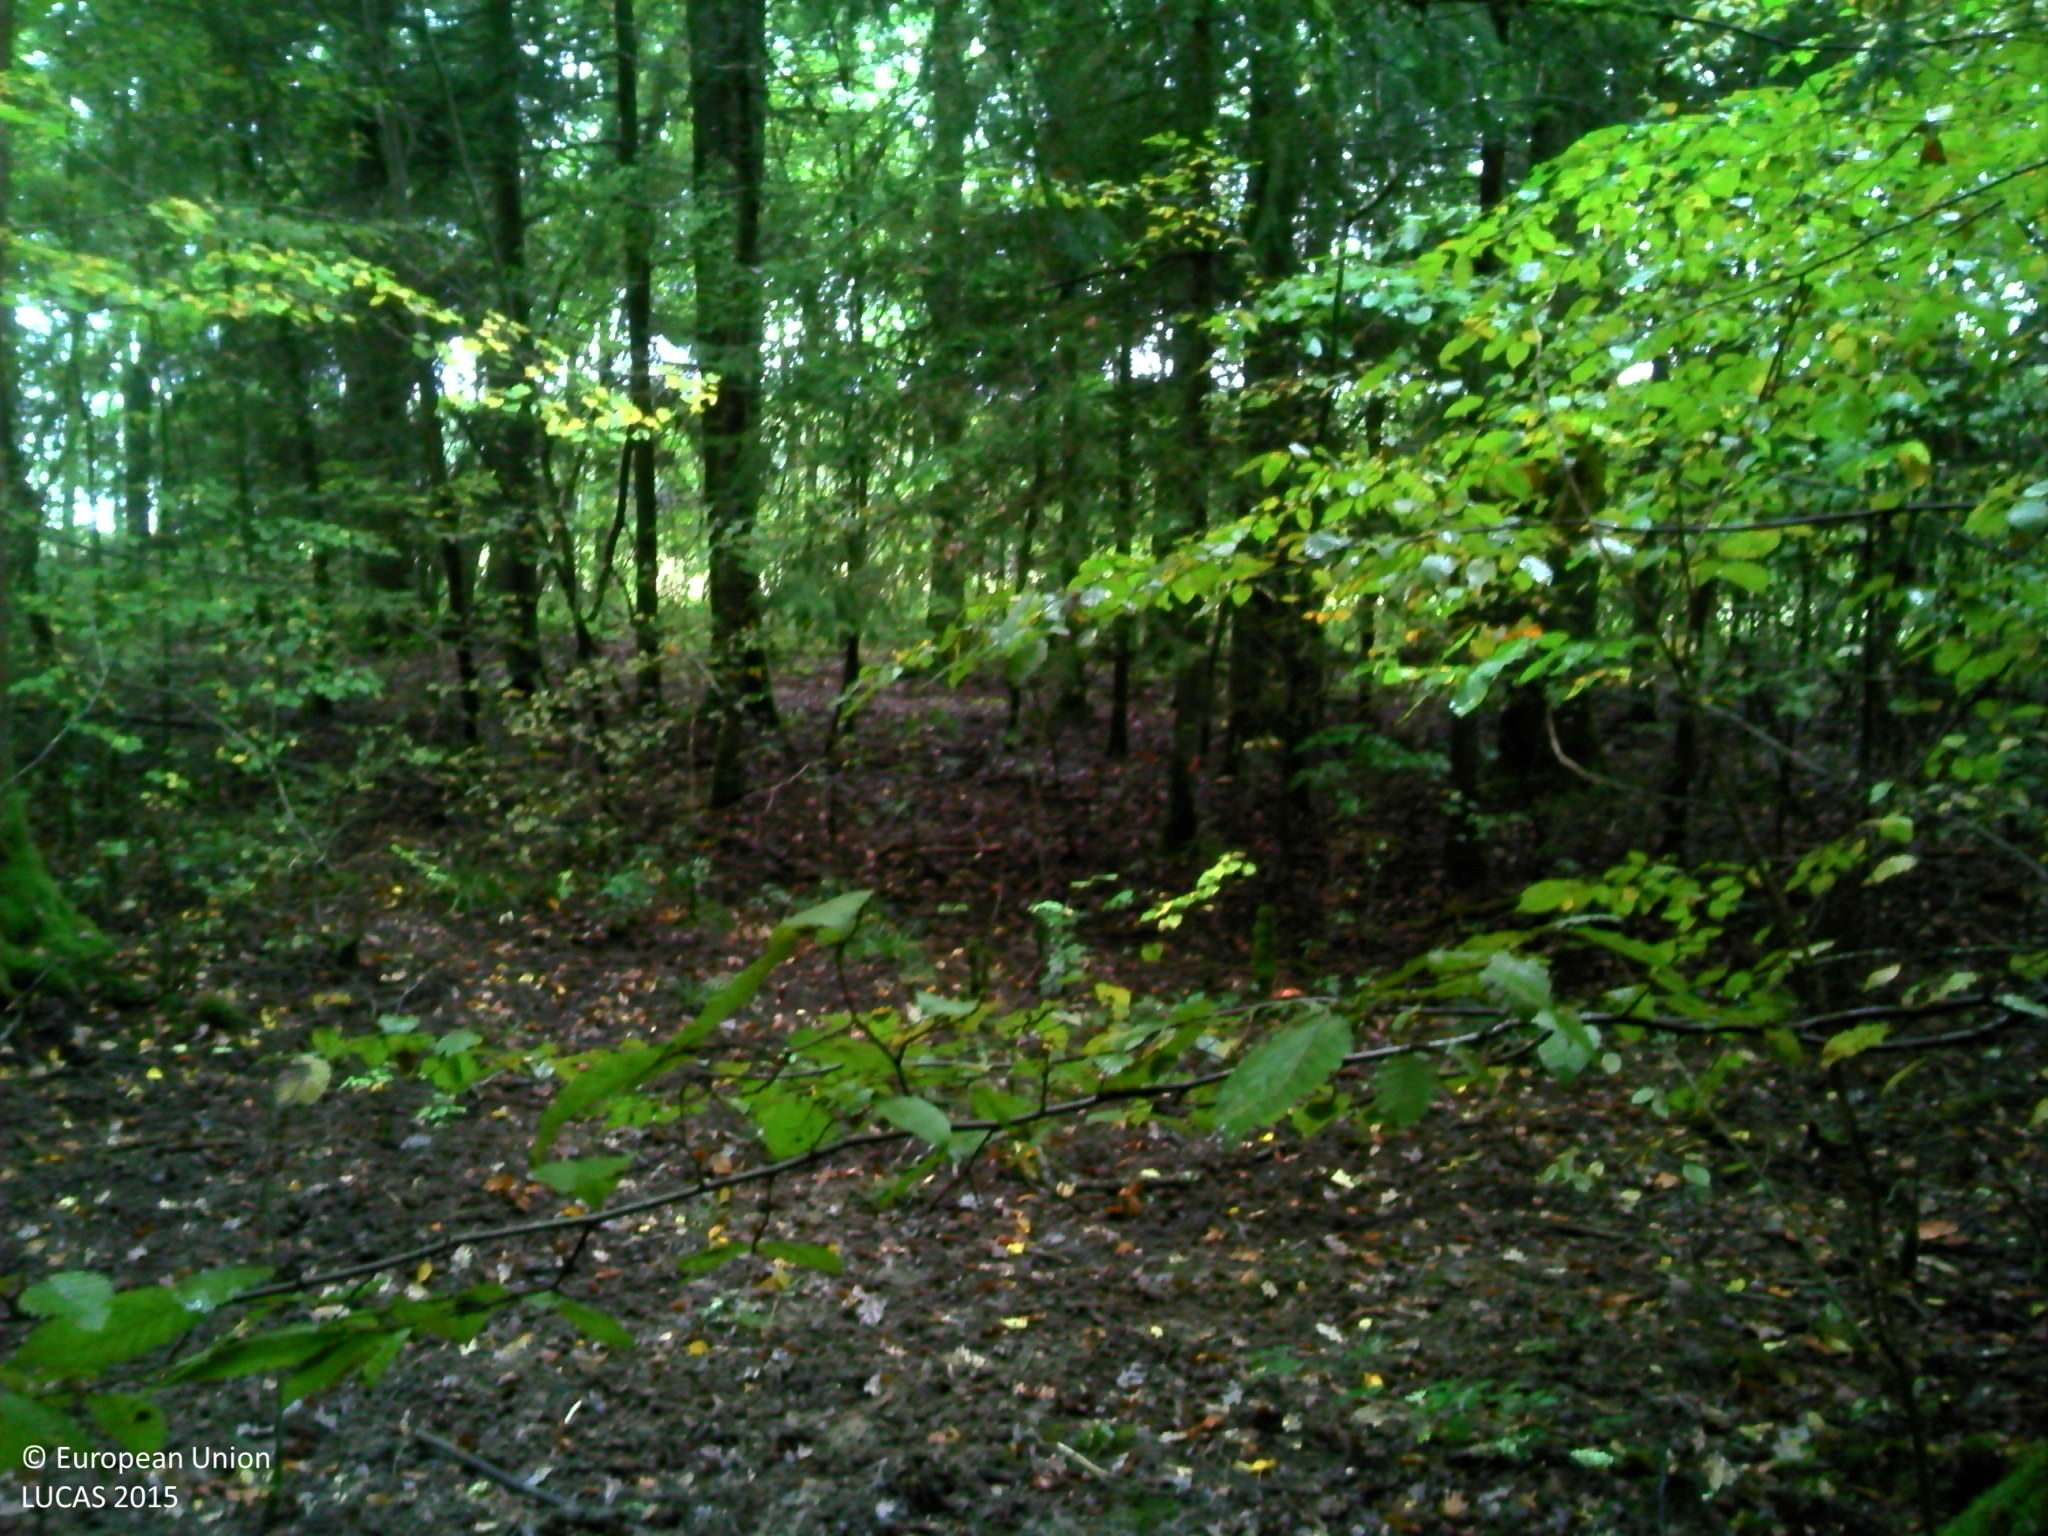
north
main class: Woodland
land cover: Spruce dominated mixed woodland
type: hemiboreal forest and nemoral coniferous forest and mixed broadleaved-coniferous forest
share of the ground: > 75 %
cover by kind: broadleaved forest trees 75 %, coniferous forest trees 25 %
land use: Forestry
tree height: > 5 m
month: October
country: FR
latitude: 48.2027
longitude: 4.3056
